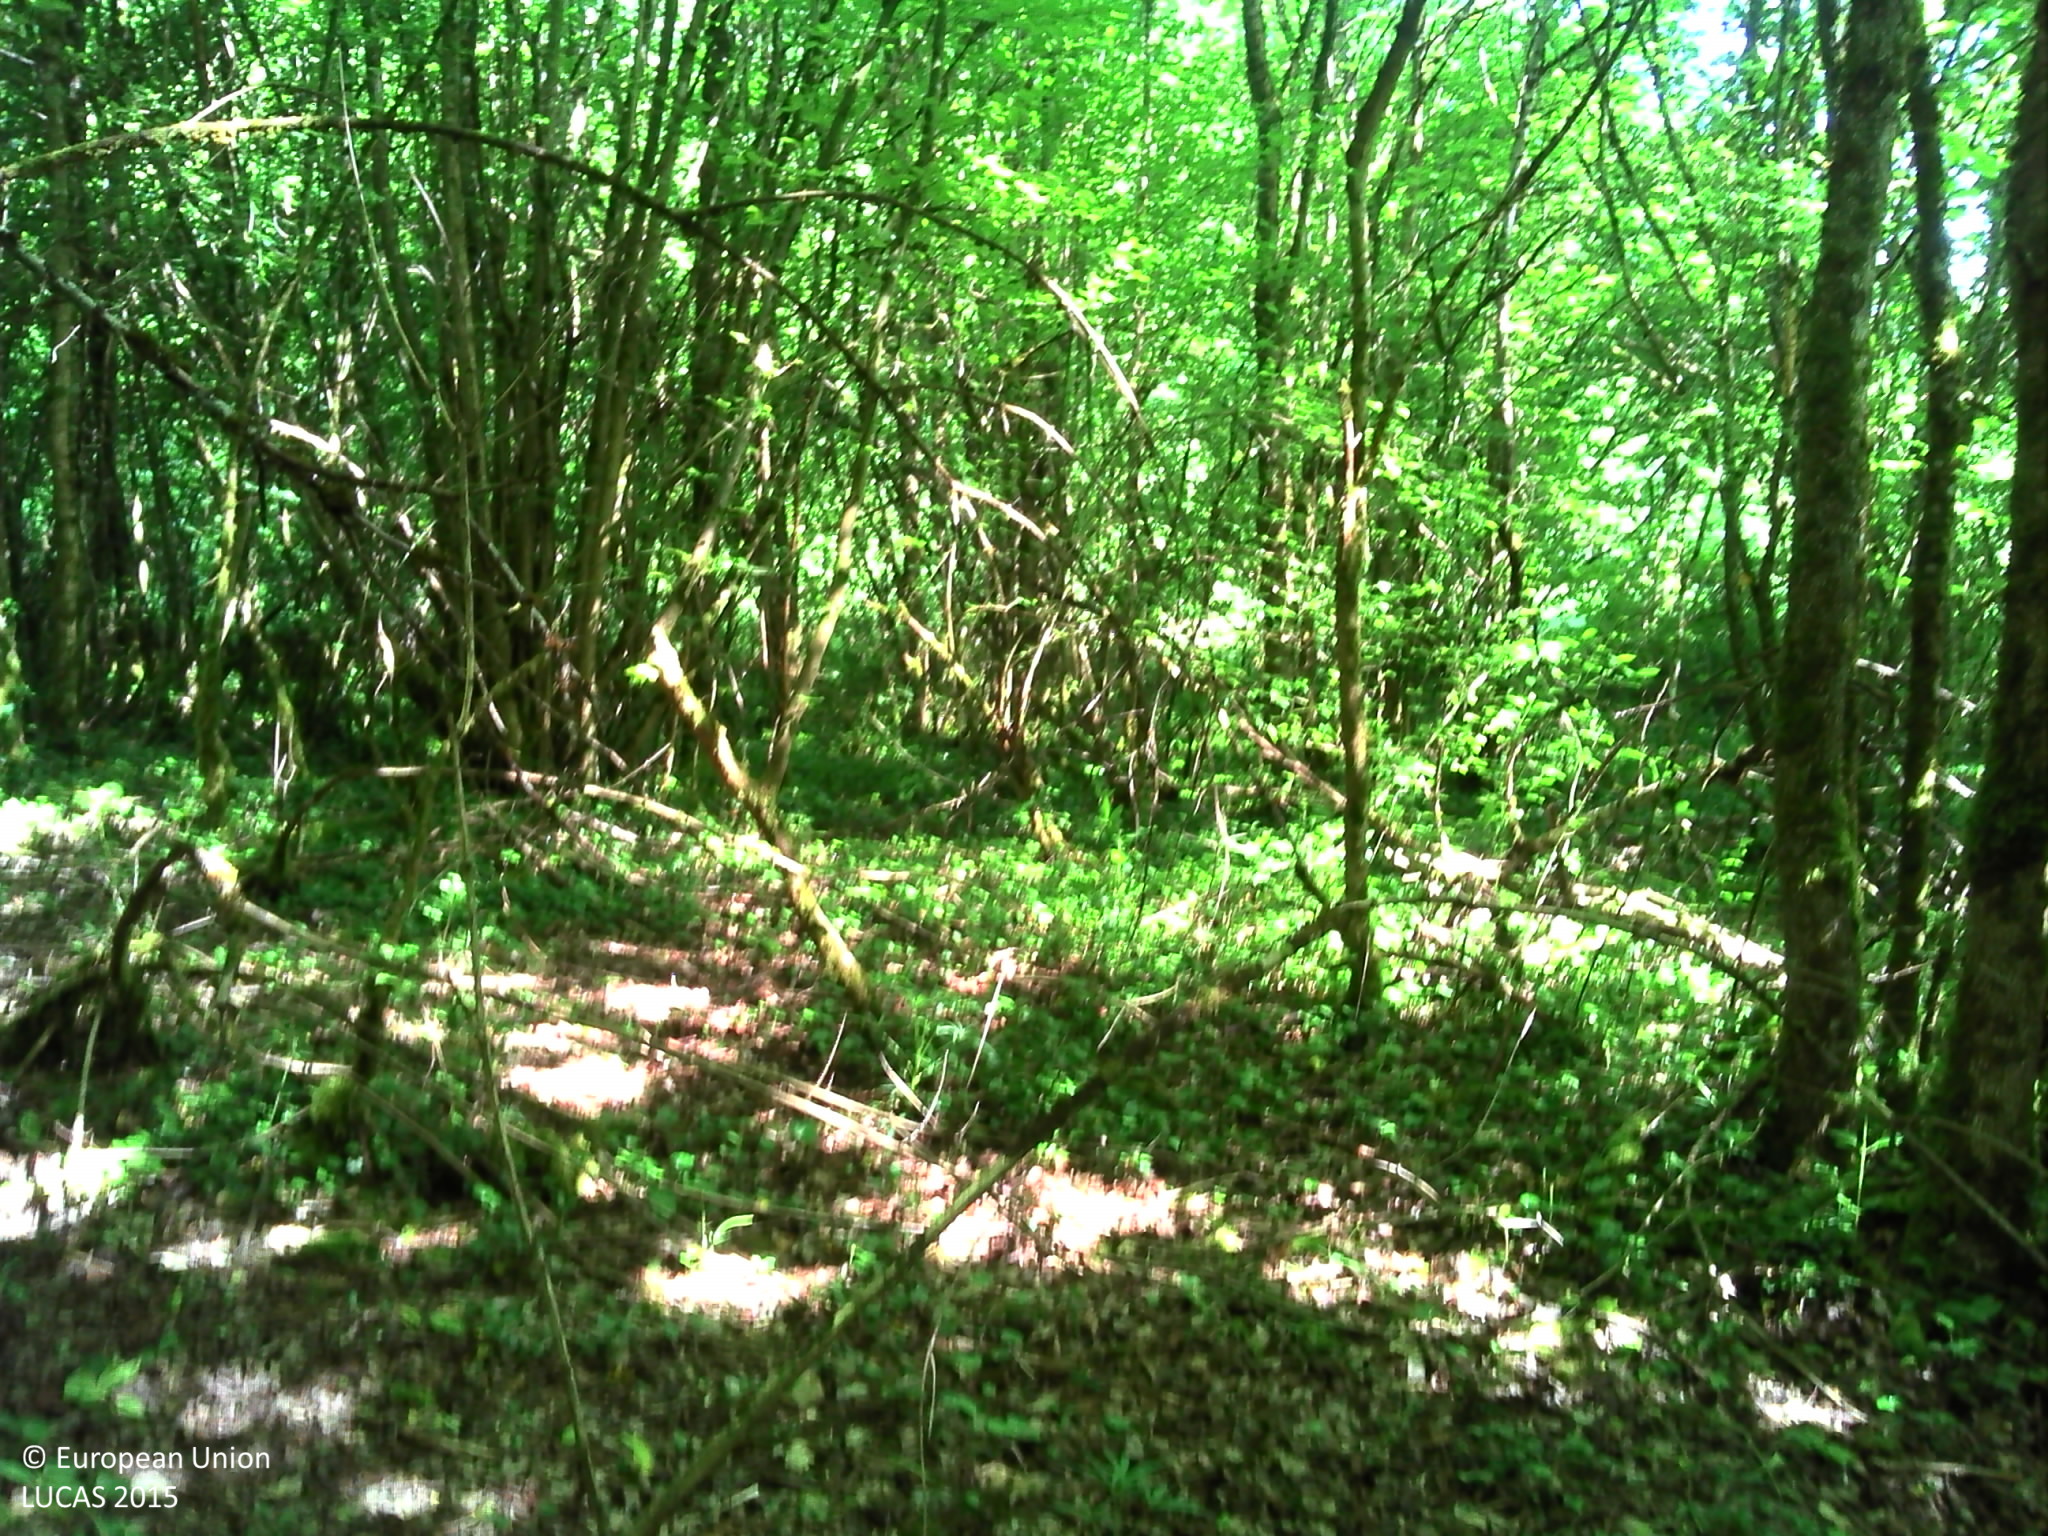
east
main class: Woodland
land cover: Broadleaved woodland
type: mesophytic deciduous forest
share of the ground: > 75 %
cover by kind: broadleaved forest trees 95 %, herbaceous plants 5 %
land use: Forestry
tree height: > 5 m
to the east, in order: Broadleaved woodland; Shruby margins; Broadleaved woodland; Spontaneously vegetated surfaces; Grass margins; Common wheat
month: May
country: FR
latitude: 47.5005
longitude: 5.0751
